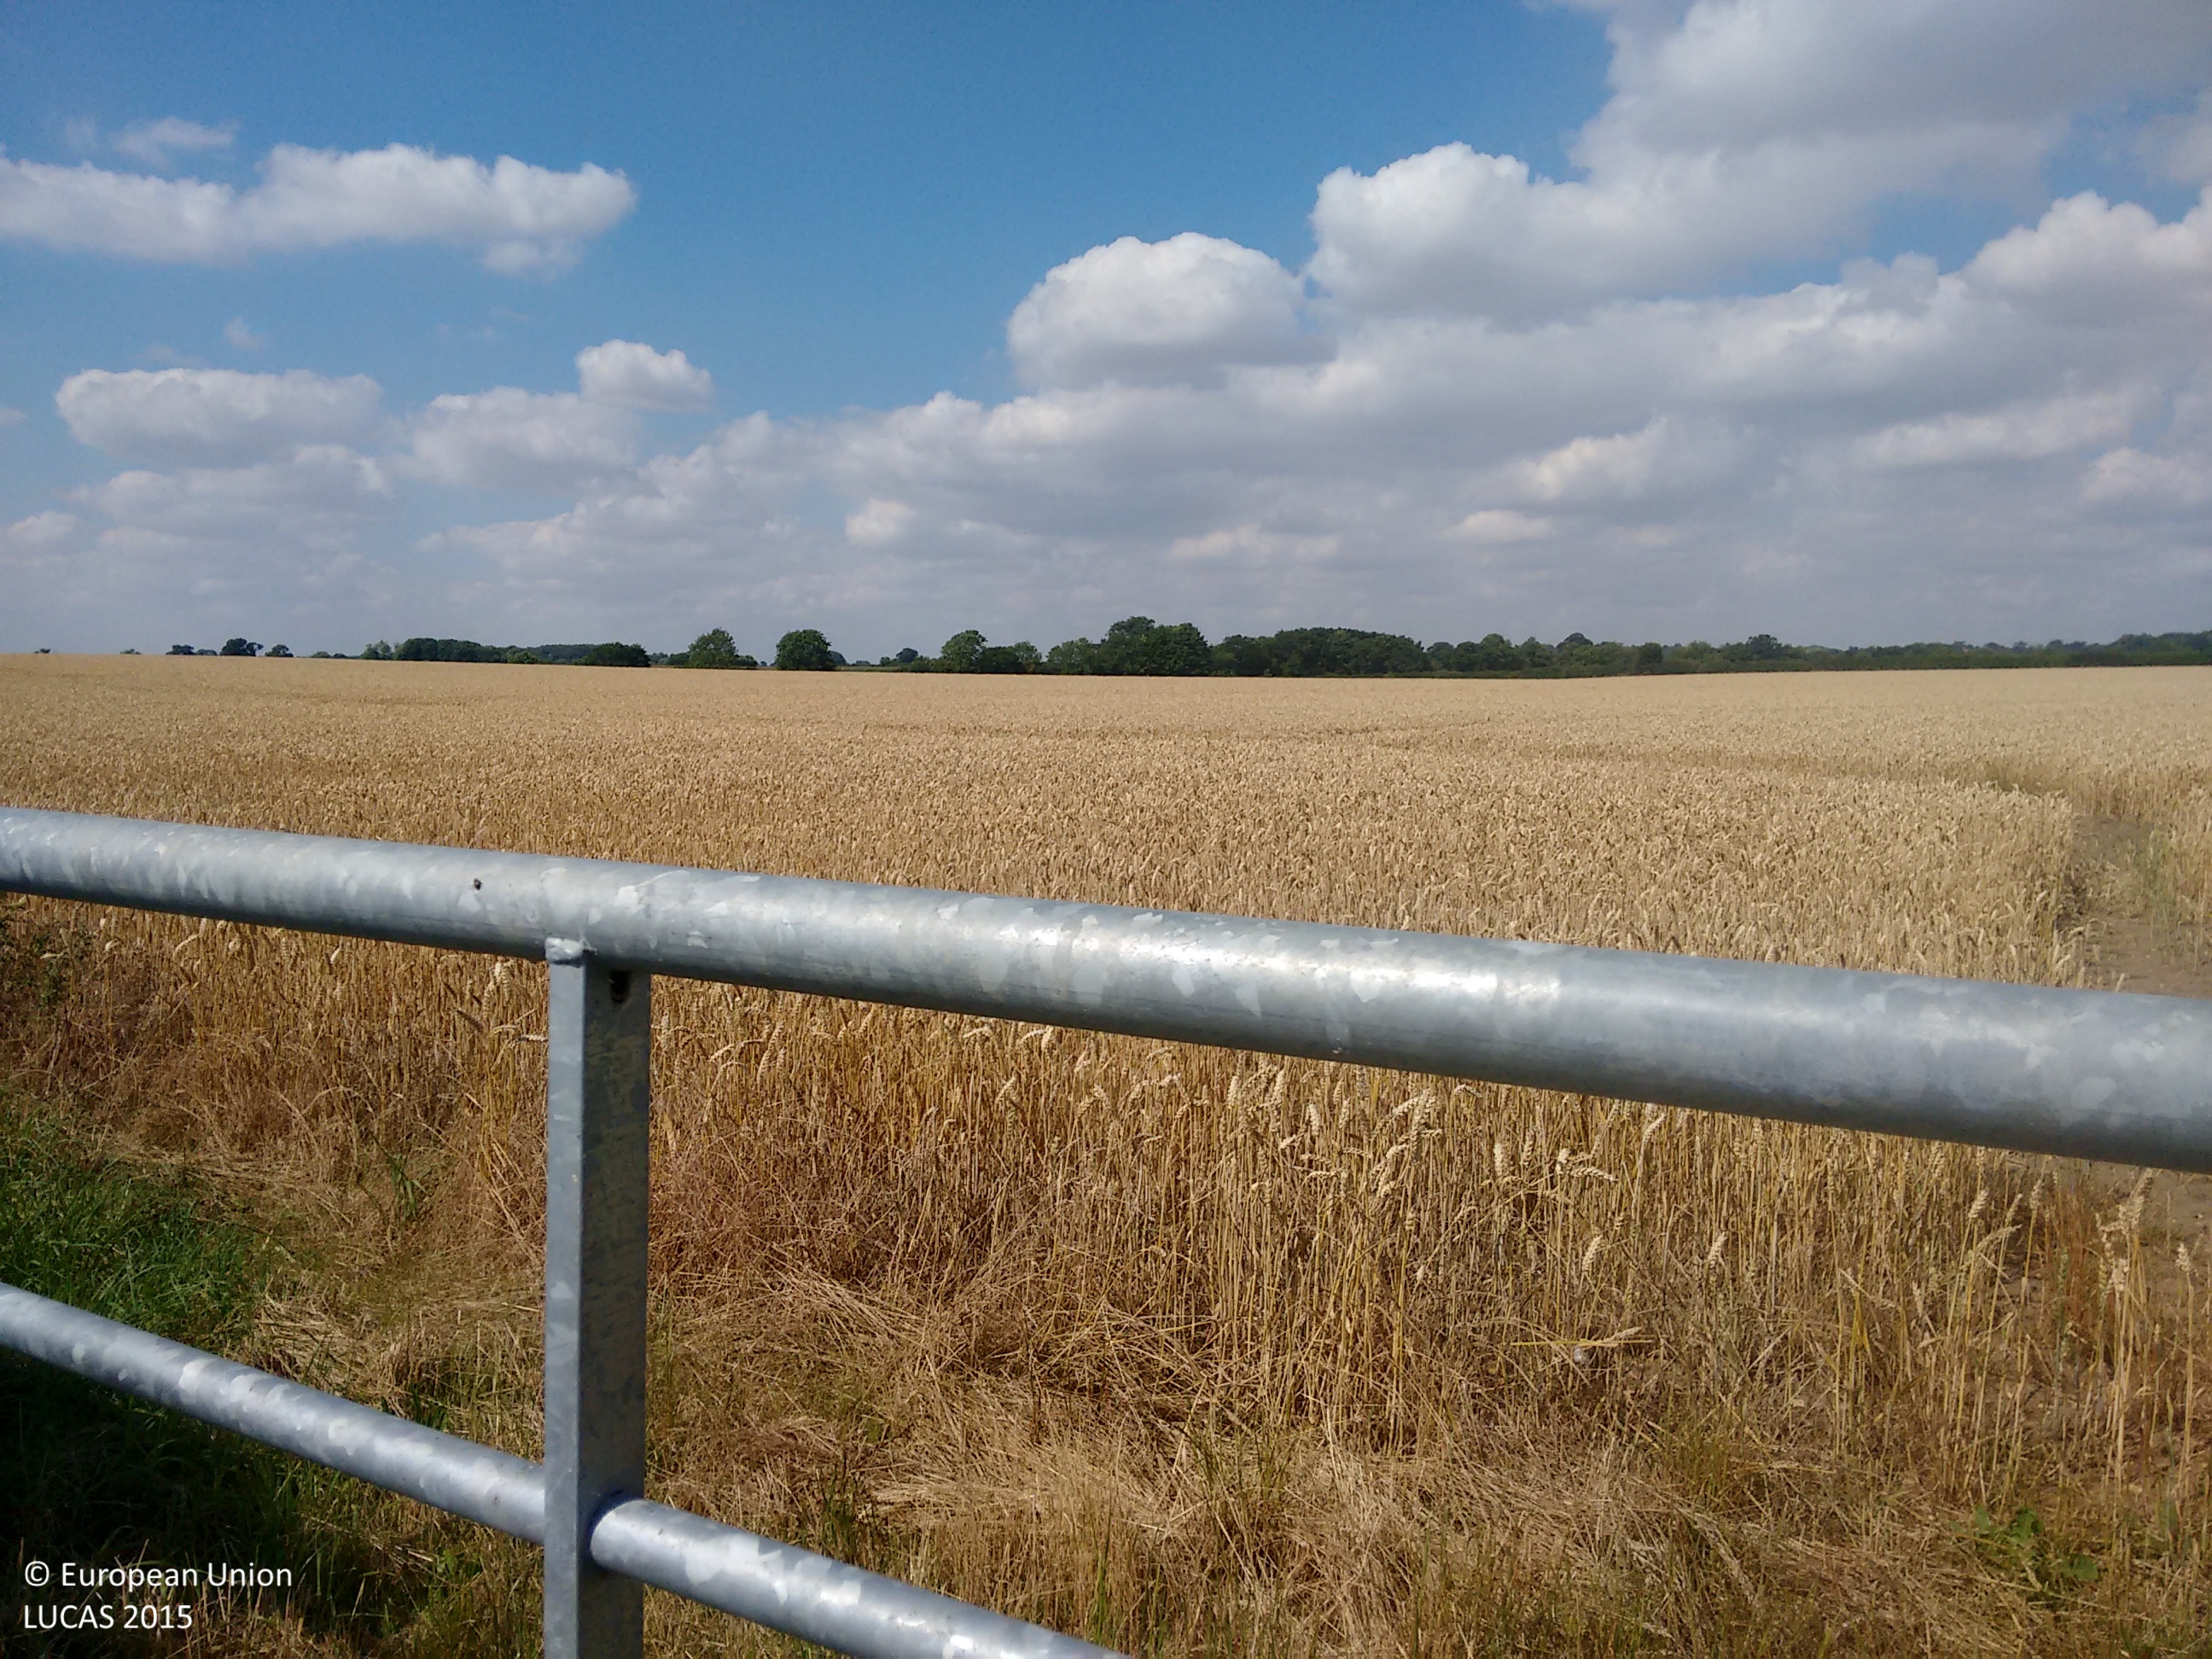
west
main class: Cropland
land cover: Common wheat
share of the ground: > 75 %
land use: Agriculture (excluding fallow land and kitchen gardens)
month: August
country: GB
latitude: 52.6366
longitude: -1.4728
